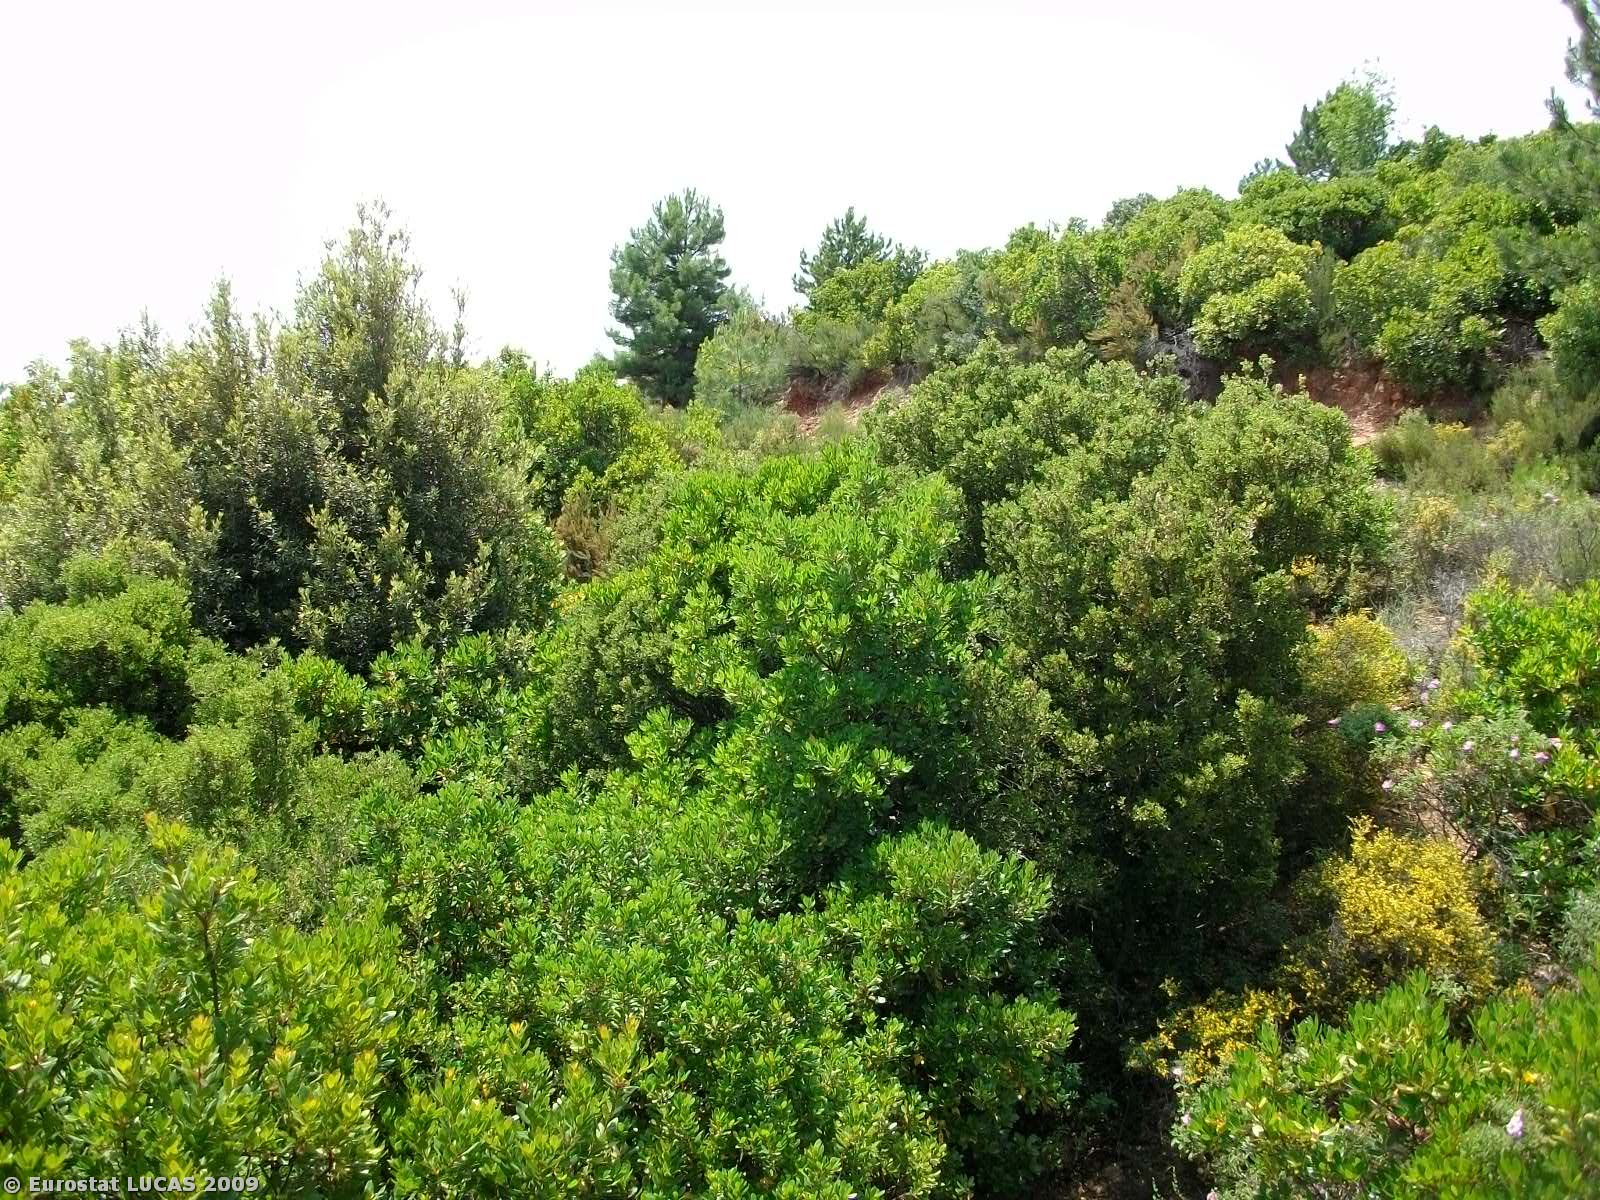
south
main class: Shrubland
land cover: Shrubland with sparse tree cover
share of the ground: > 75 %
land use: Unused
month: June
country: GR
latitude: 40.3561
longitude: 23.4924
